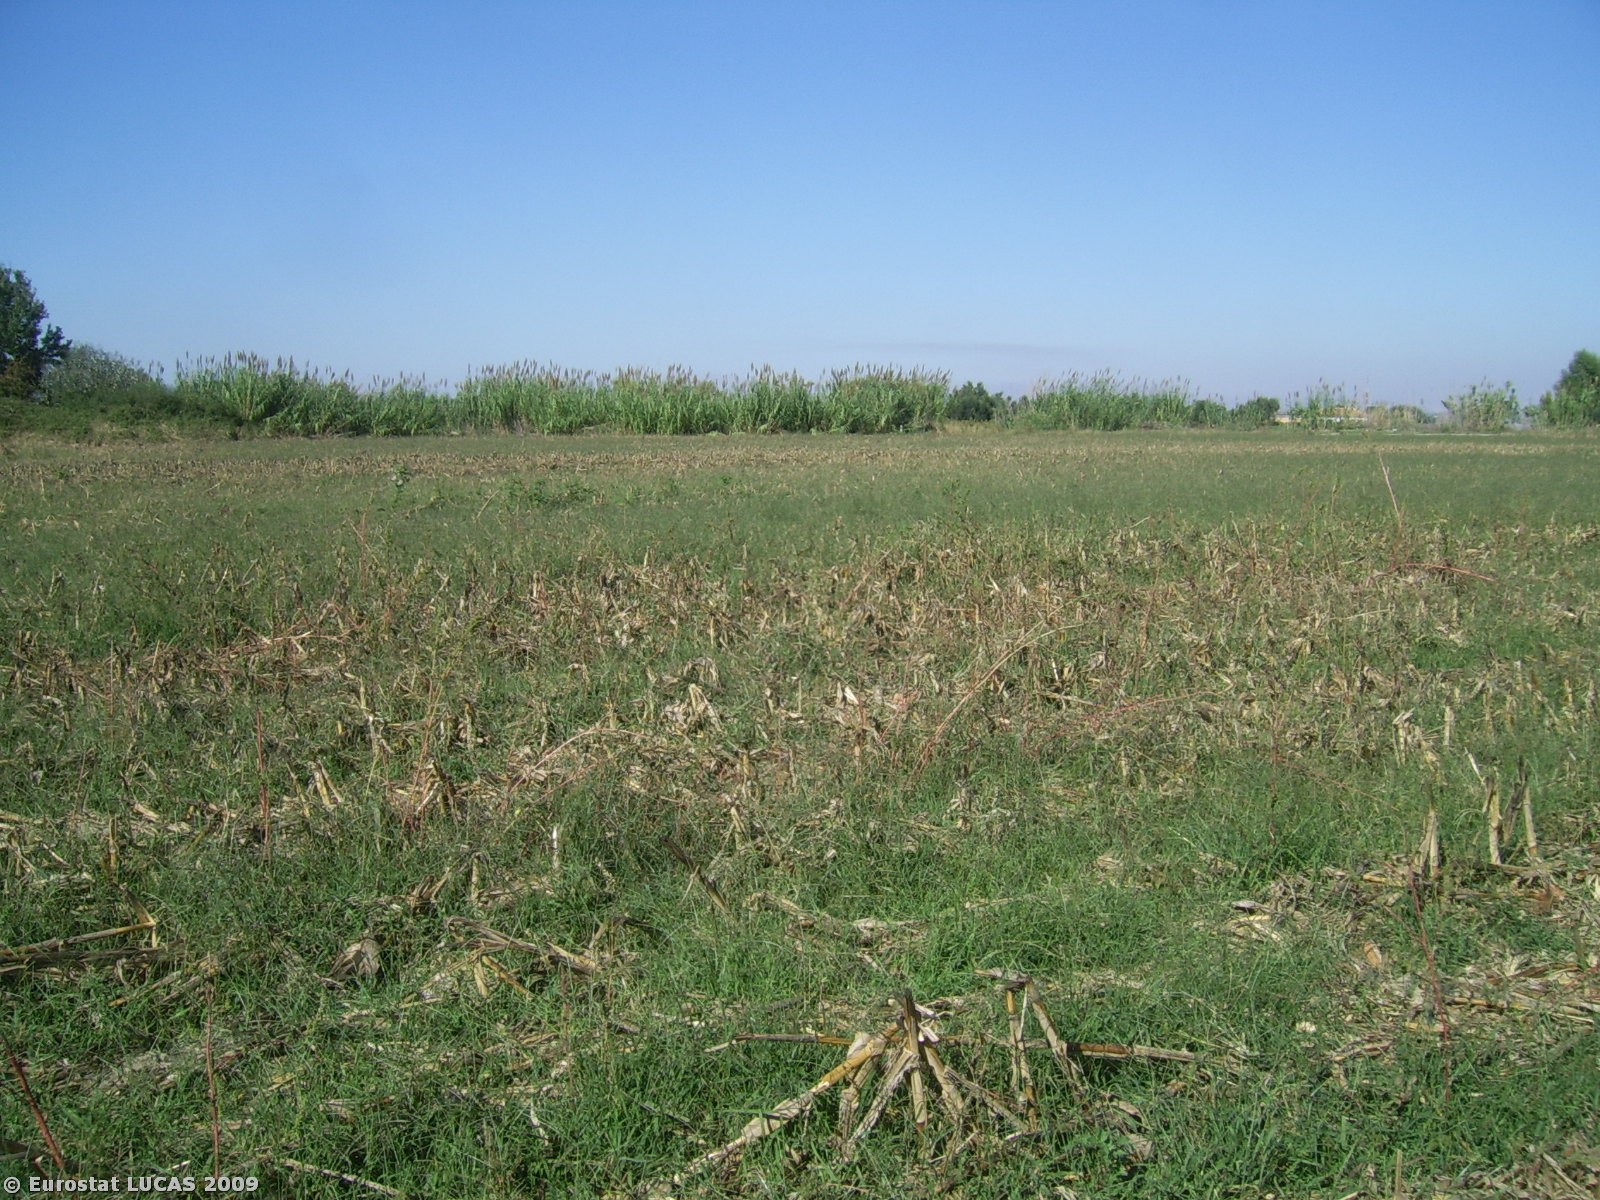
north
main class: Cropland
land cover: Maize
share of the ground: < 10 %
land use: Agriculture (excluding fallow land and kitchen gardens)
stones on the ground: < 10 %
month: October
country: GR
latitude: 37.8207
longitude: 21.3088
